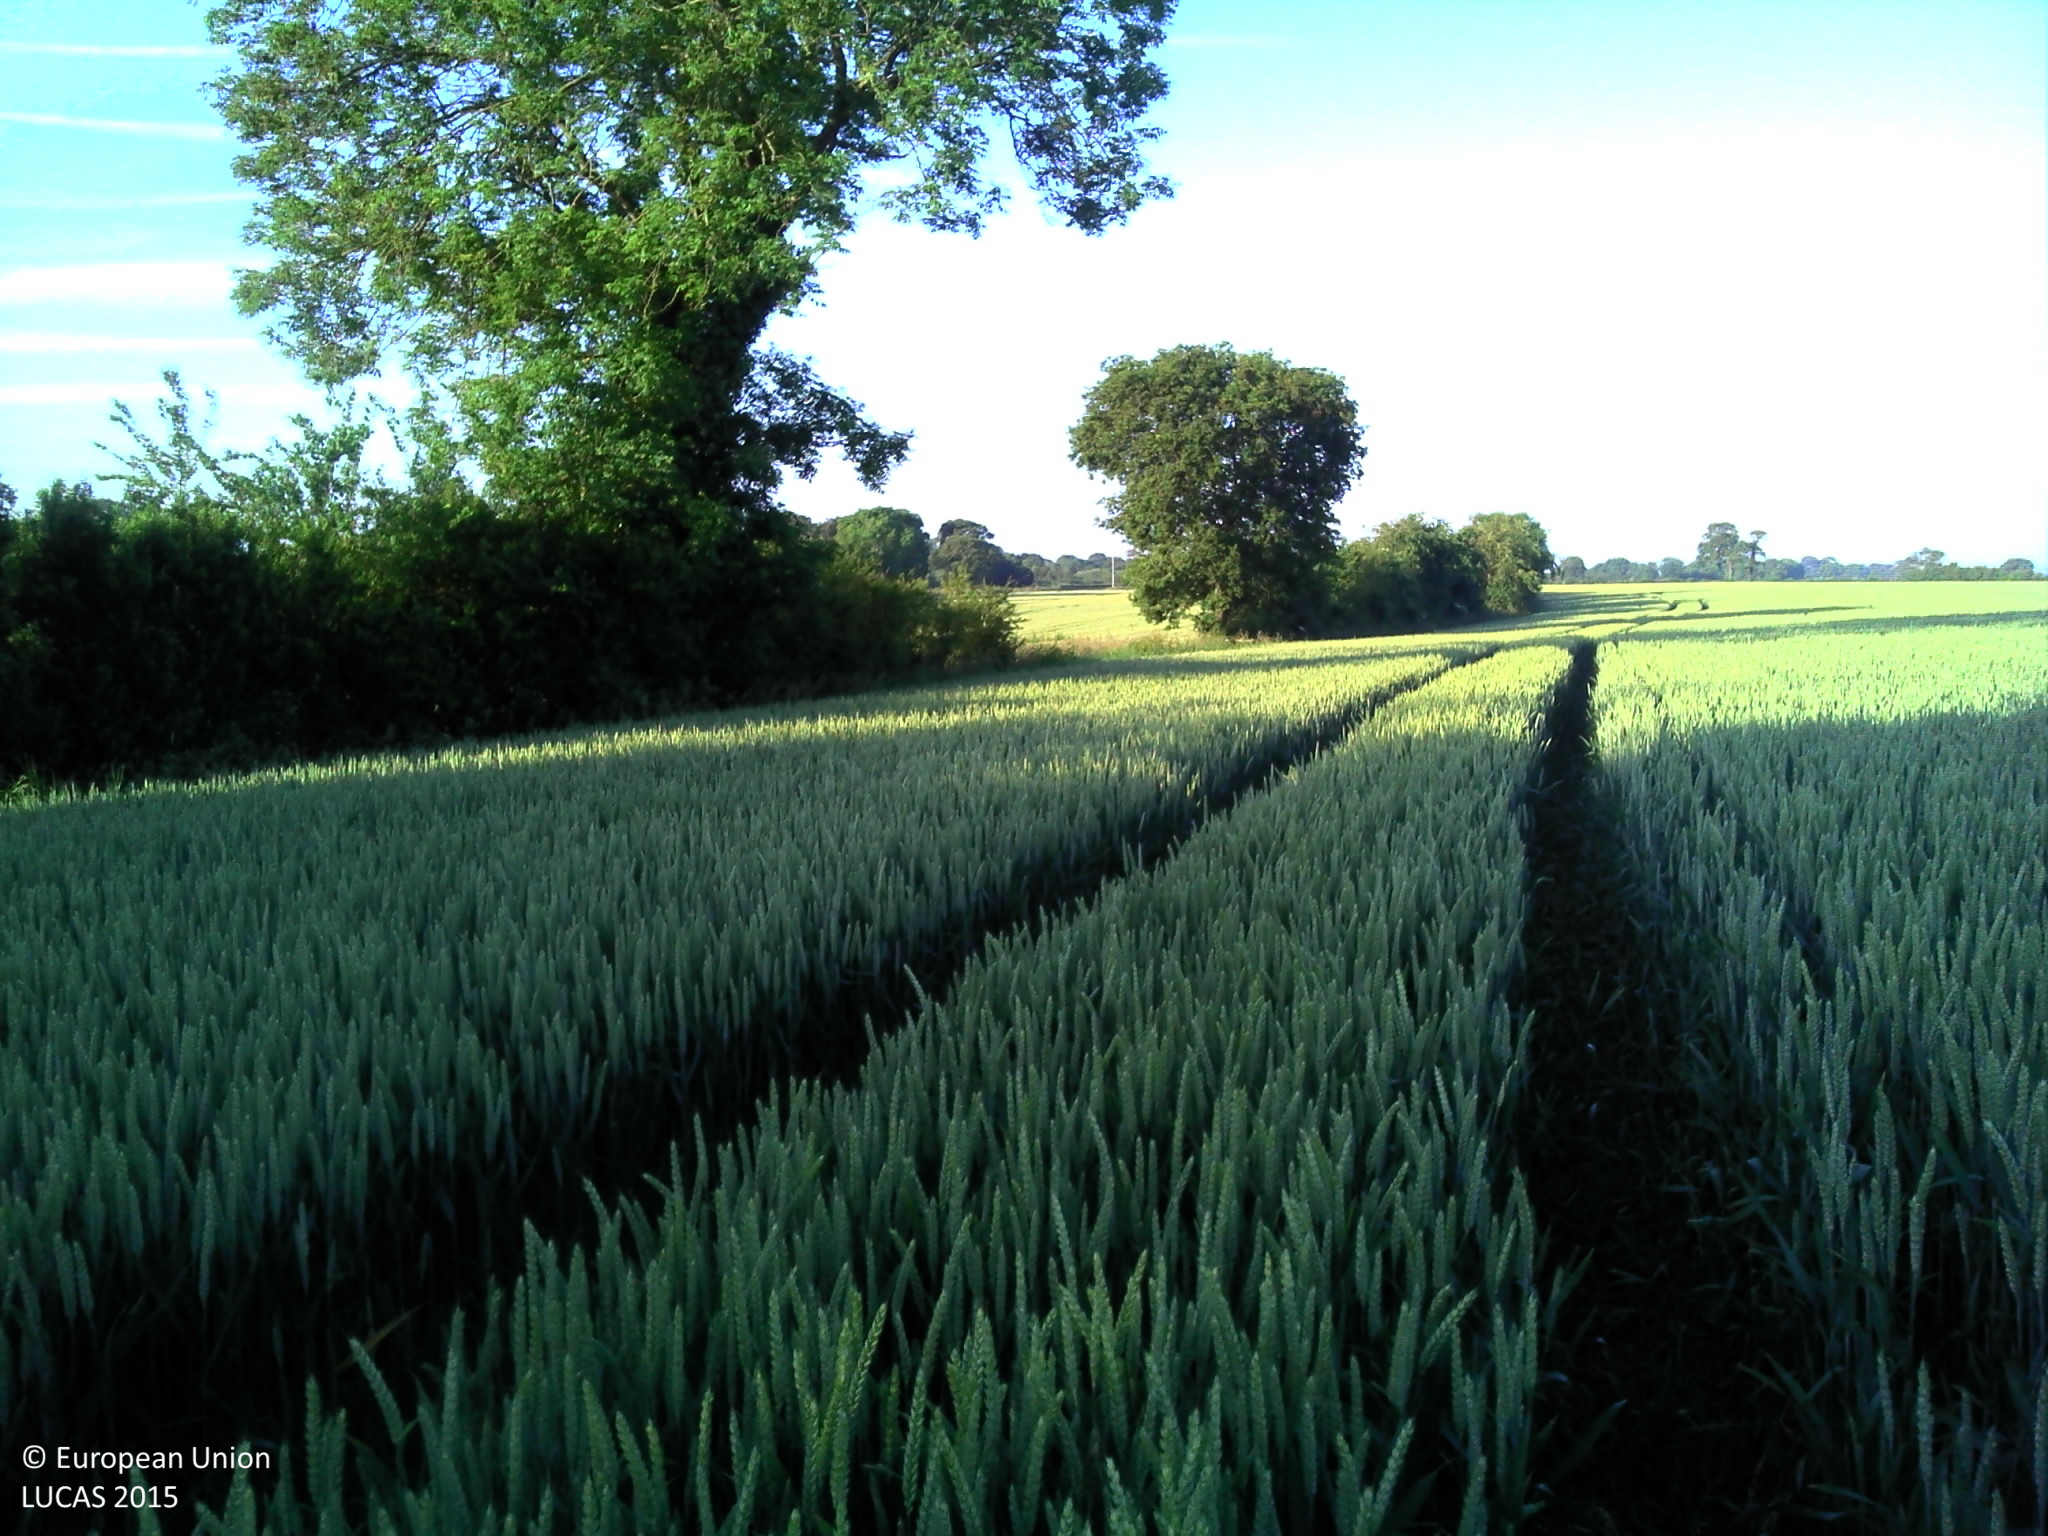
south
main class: Cropland
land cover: Common wheat
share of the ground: > 75 %
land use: Agriculture (excluding fallow land and kitchen gardens)
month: June
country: FR
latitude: 49.3404
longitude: -1.3745
